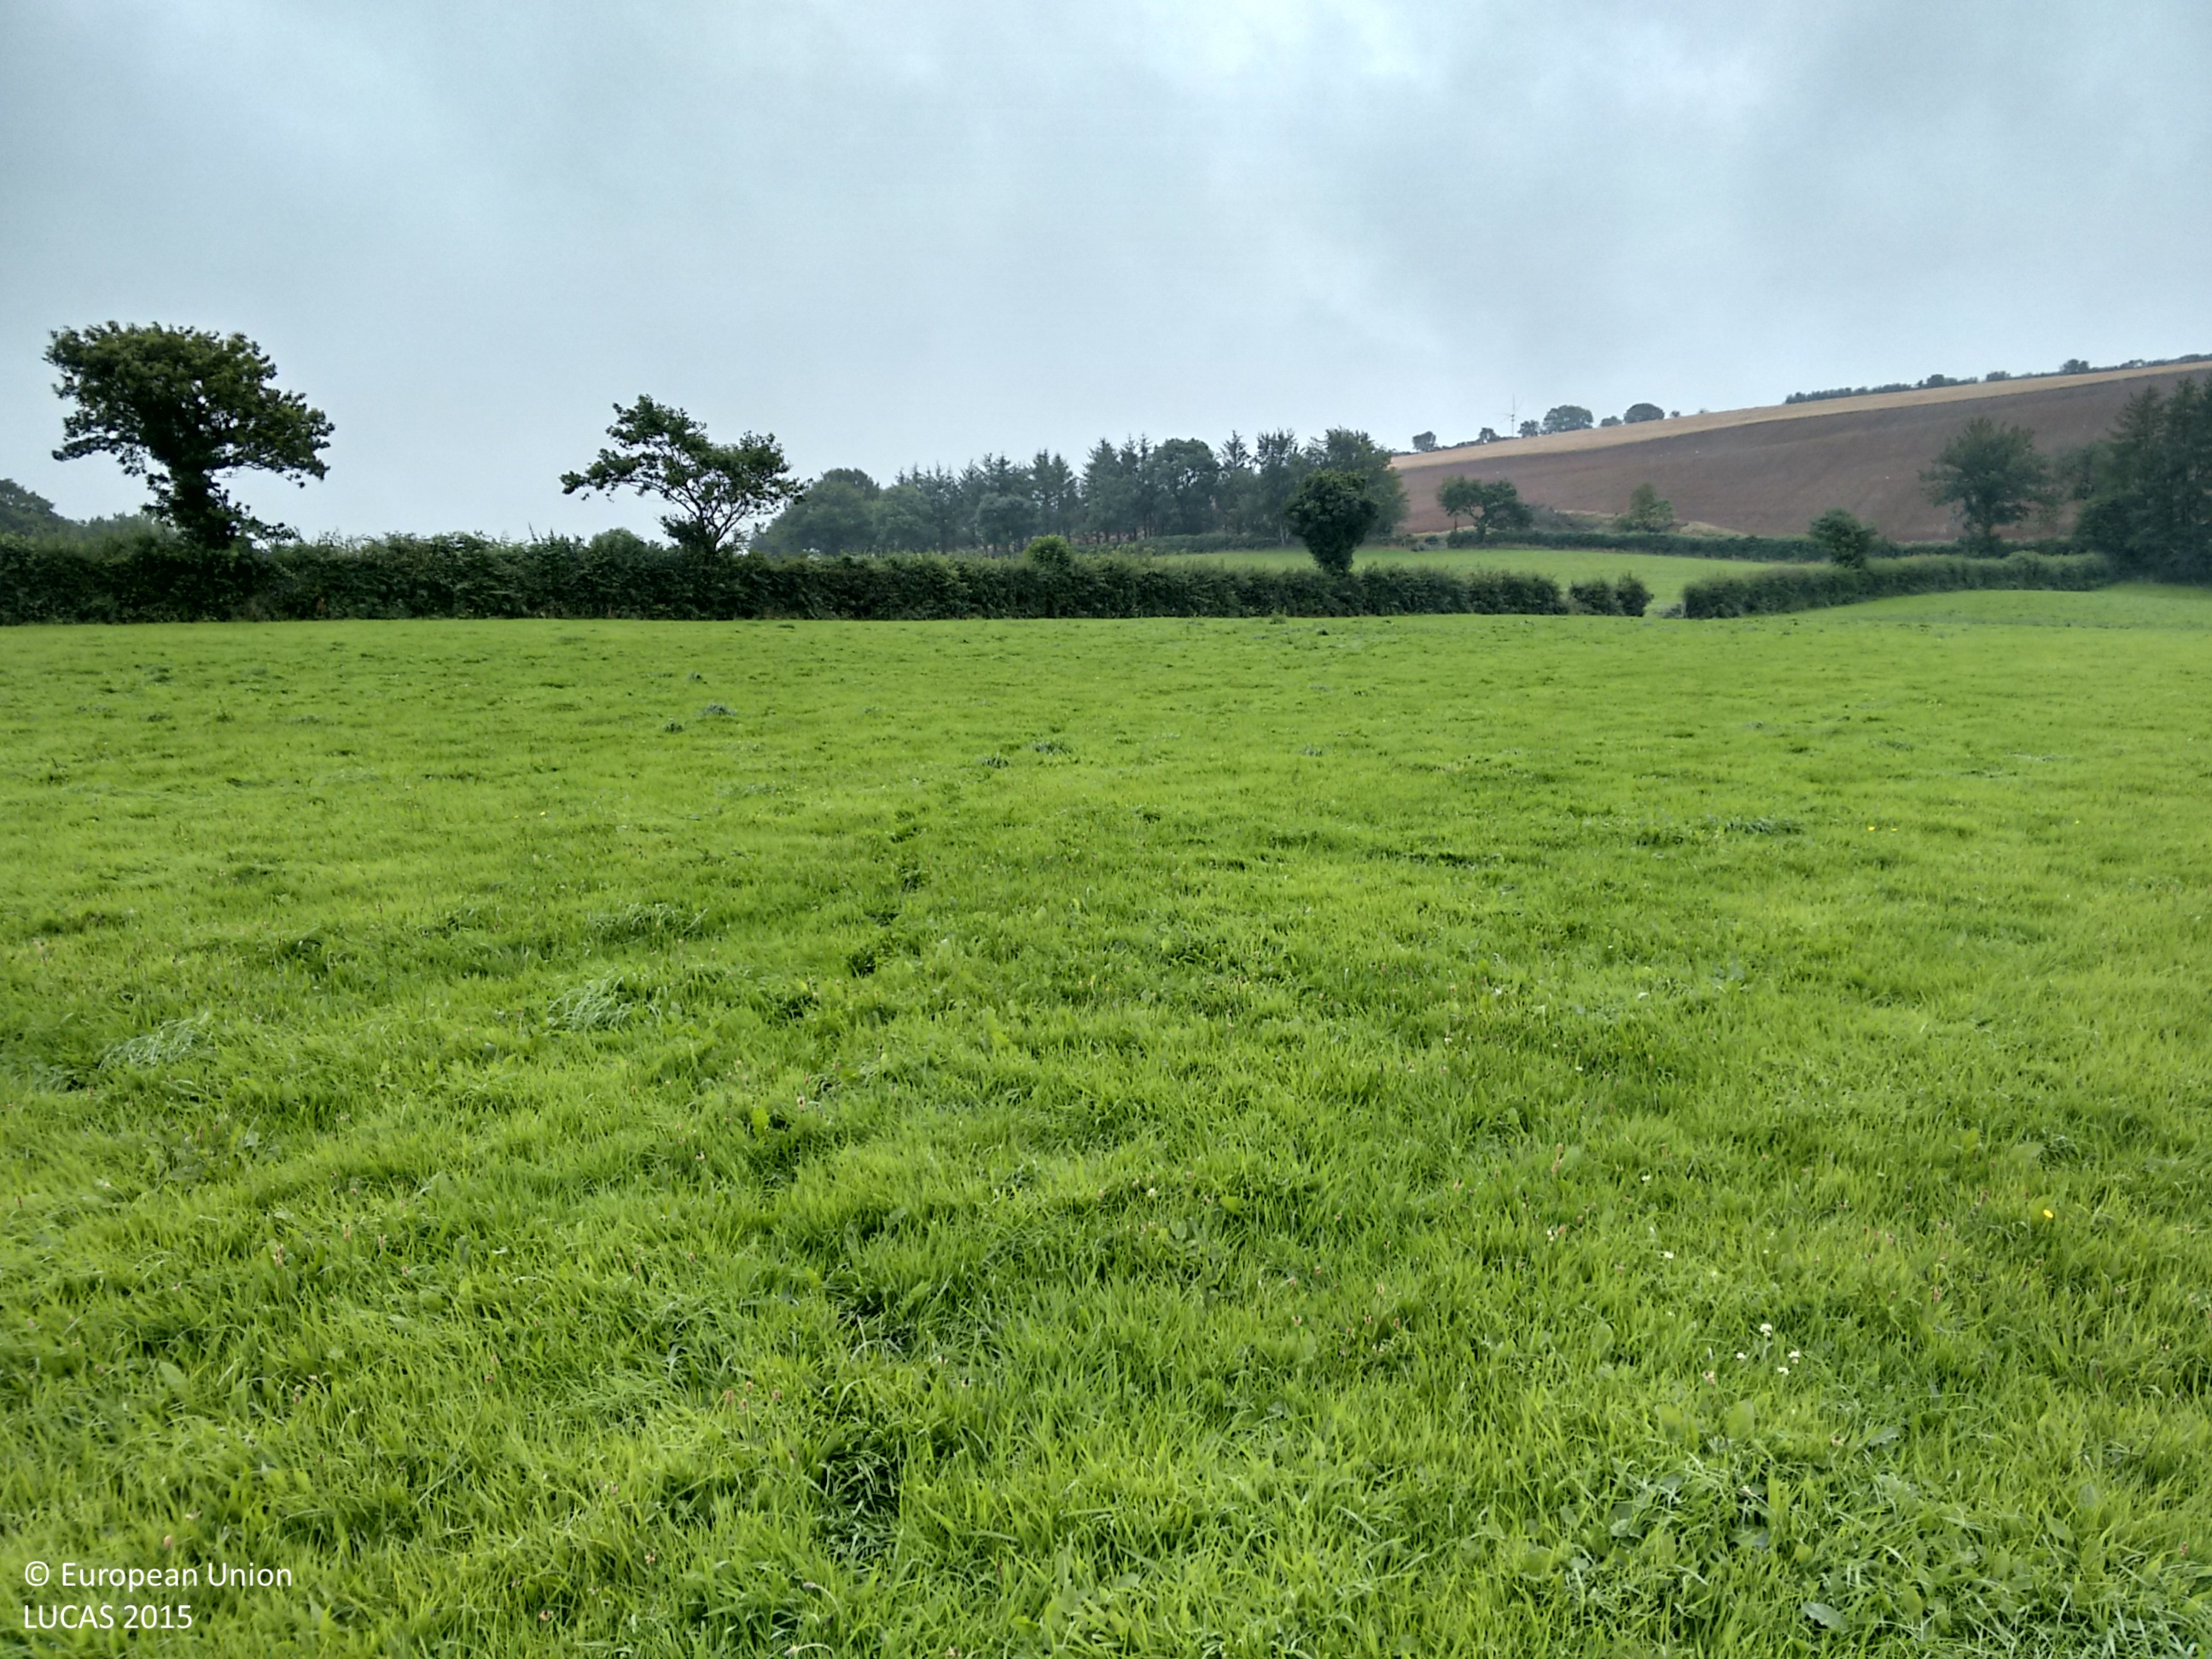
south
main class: Grassland
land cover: Grassland without tree/shrub cover
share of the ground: > 75 %
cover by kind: herbaceous plants 100 %
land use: Agriculture (excluding fallow land and kitchen gardens)
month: August
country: GB
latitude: 52.0162
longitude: -4.4570
